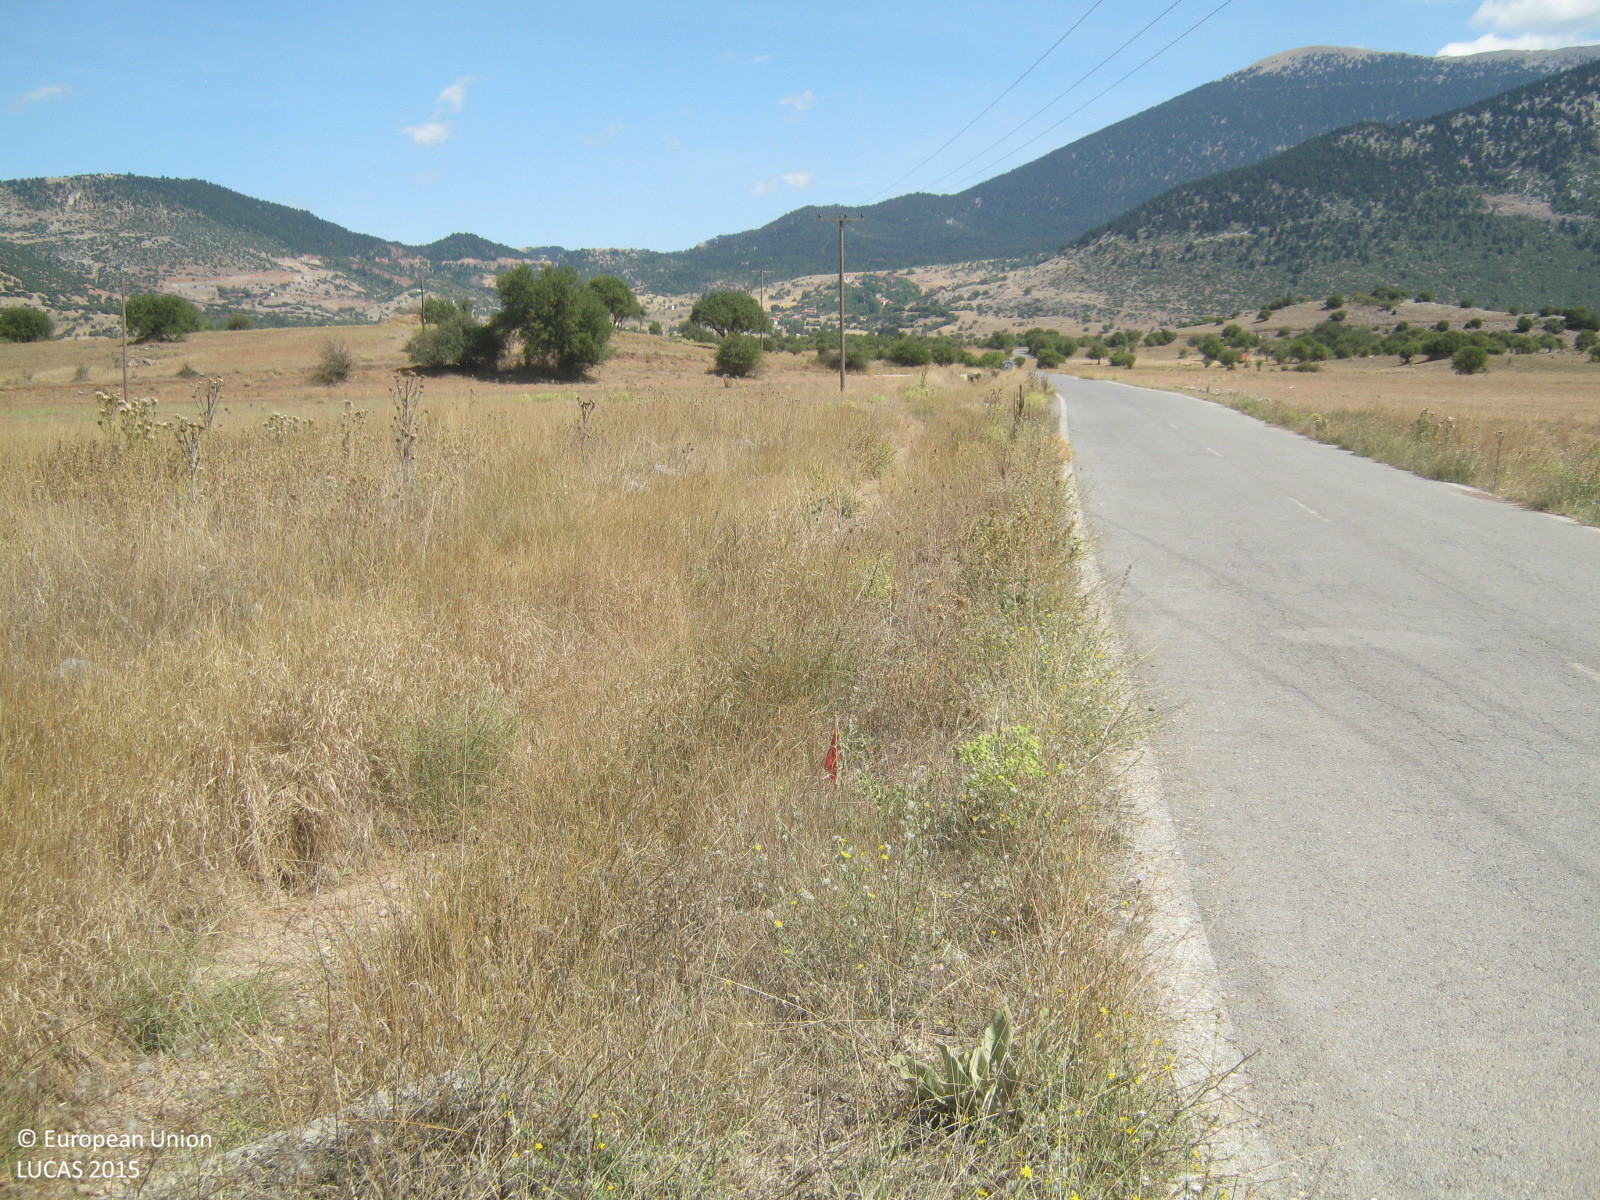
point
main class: Grassland
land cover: Spontaneously vegetated surfaces
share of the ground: > 75 %
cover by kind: herbaceous plants 95 %, unconsolidated bare surface 5 %
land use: Fallow land
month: September
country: GR
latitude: 37.9773
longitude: 22.1136
